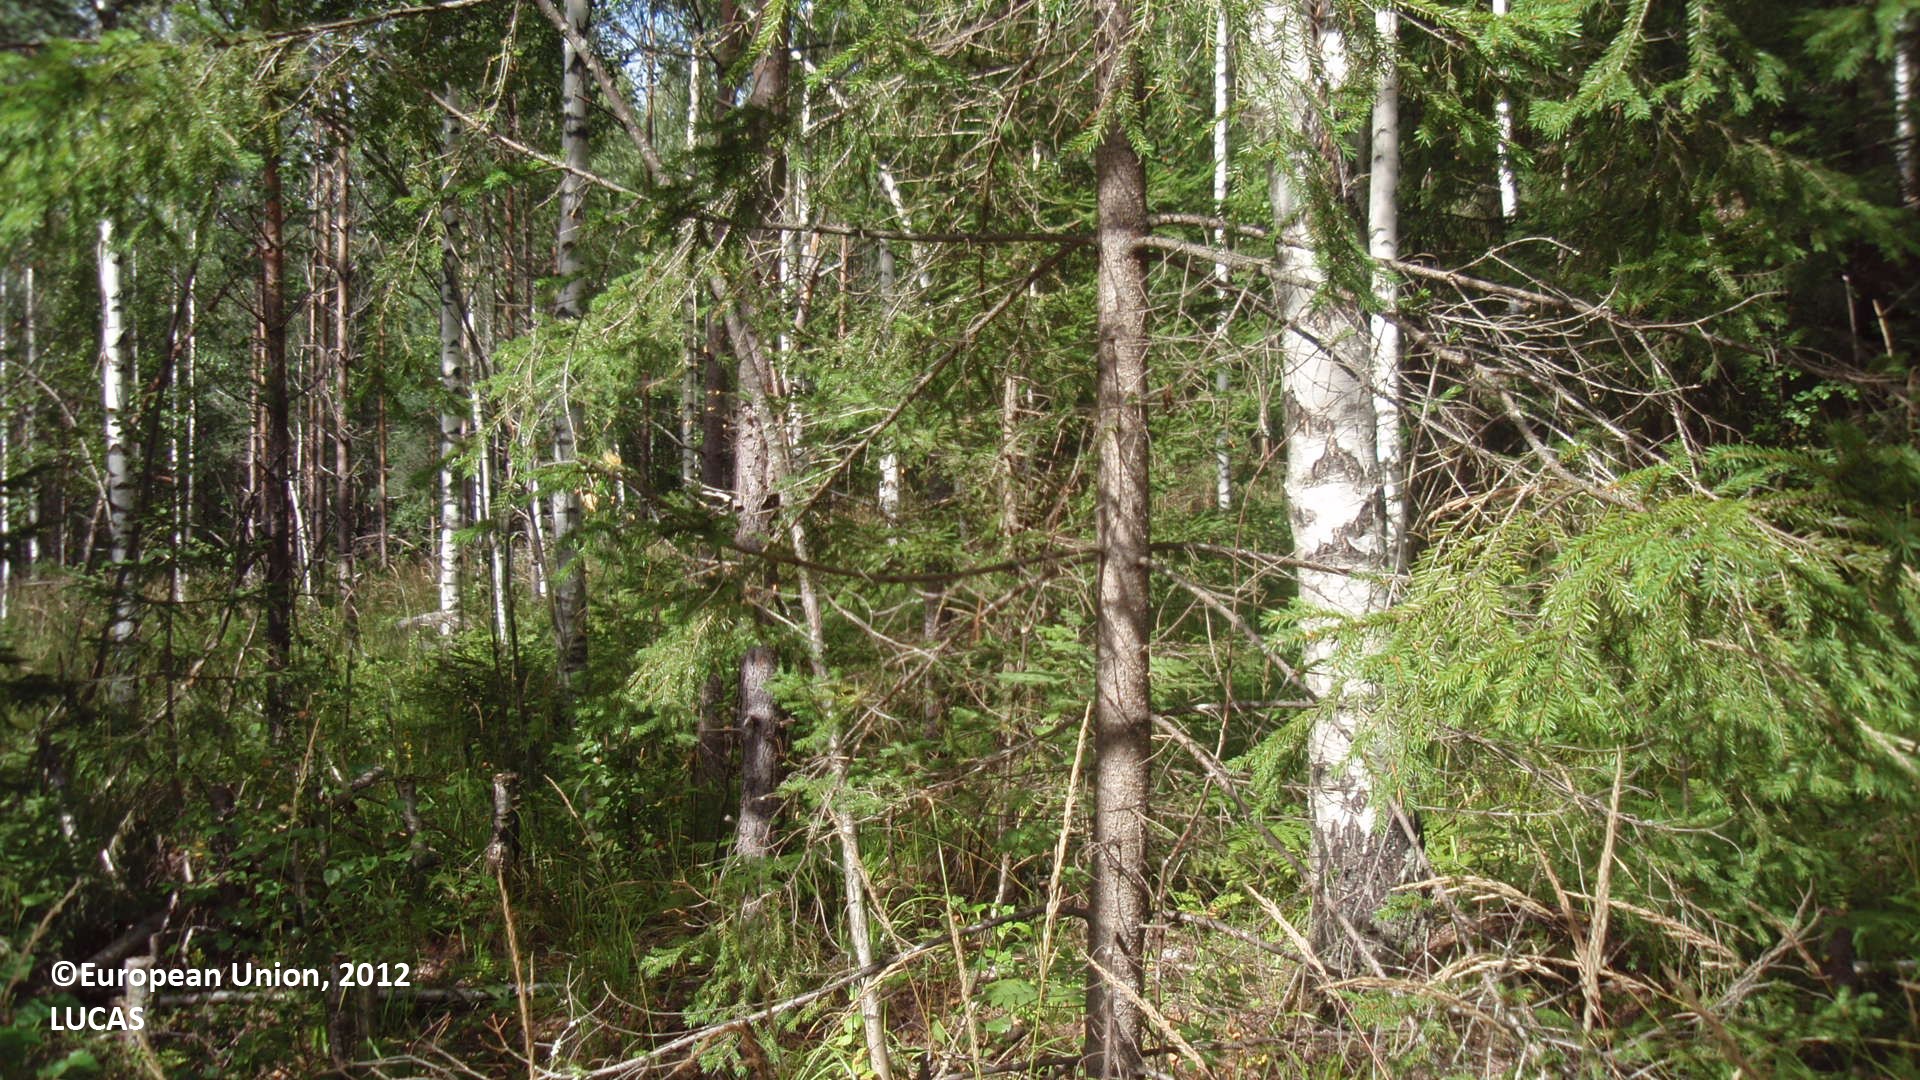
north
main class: Woodland
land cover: Pine dominated mixed woodland
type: boreal forest
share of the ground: 50 - 75 %
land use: Forestry
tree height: > 5 m
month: August
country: FI
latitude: 61.0113
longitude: 26.9419
